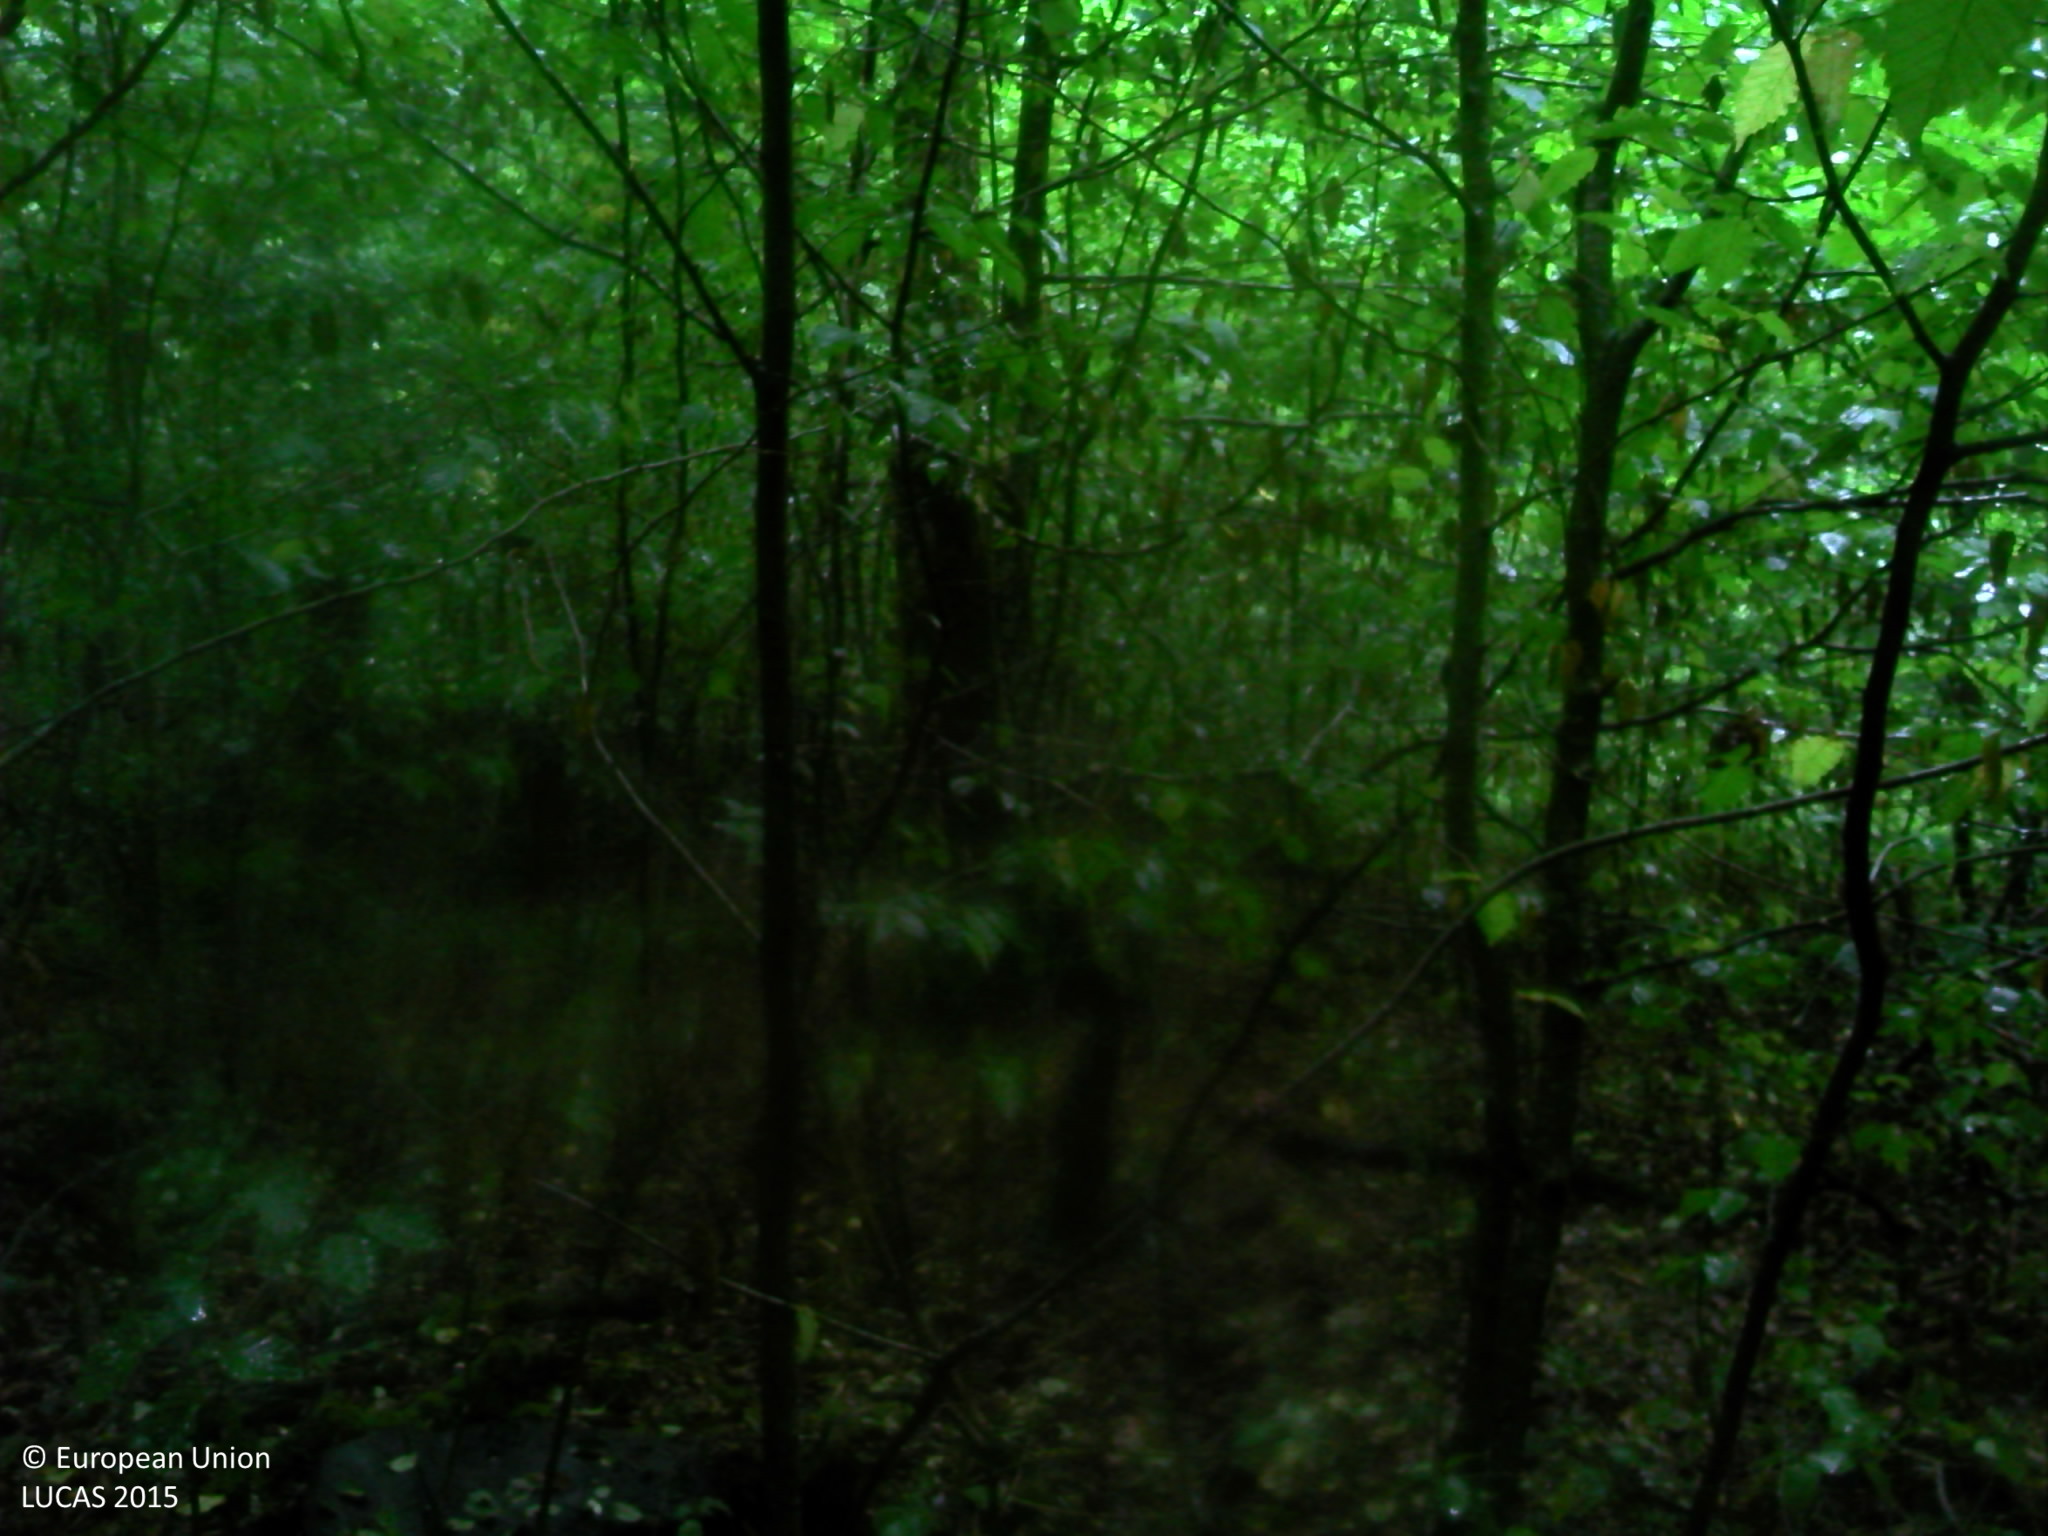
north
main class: Woodland
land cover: Broadleaved woodland
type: mesophytic deciduous forest
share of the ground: > 75 %
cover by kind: broadleaved forest trees 100 %
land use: Forestry
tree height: > 5 m
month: July
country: BE
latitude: 50.1302
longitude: 4.6385
